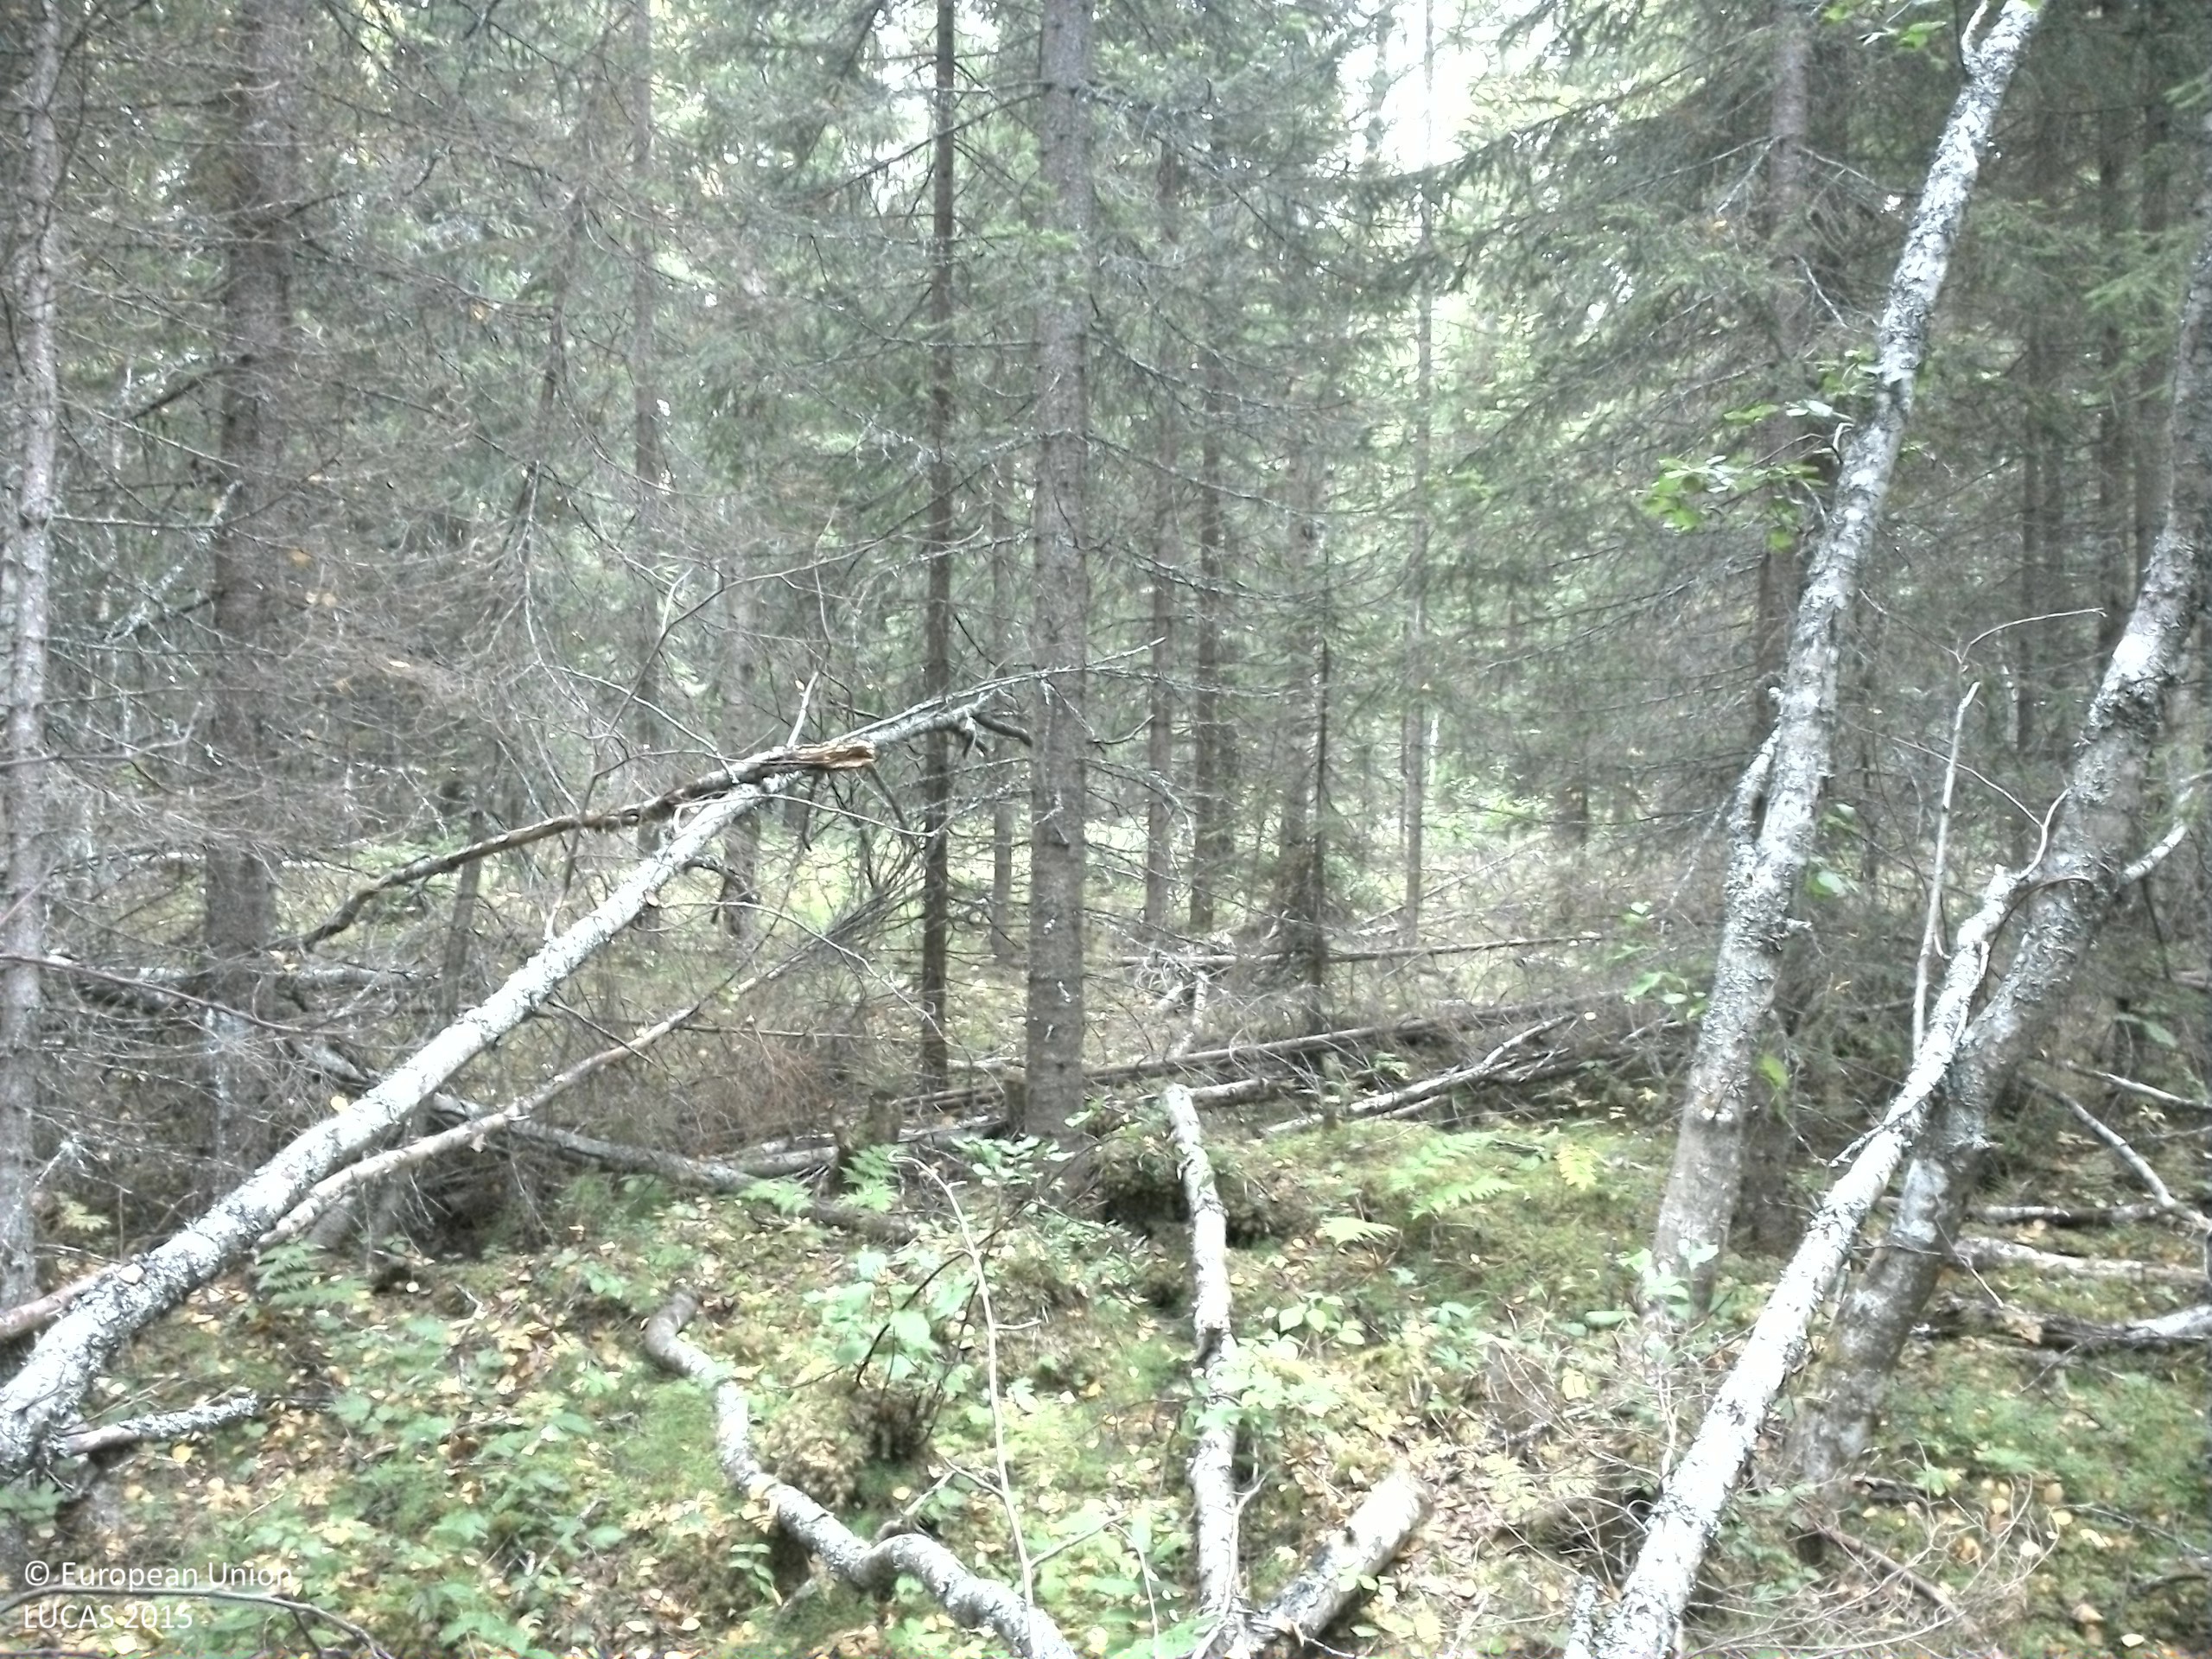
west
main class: Woodland
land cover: Spruce dominated mixed woodland
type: boreal forest
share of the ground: > 75 %
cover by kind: coniferous forest trees 55 %, broadleaved forest trees 20 %, lichens and mosses 10 %, unconsolidated bare surface 10 %, shrubs 5 %
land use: Forestry
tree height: > 5 m
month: September
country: SE
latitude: 63.6371
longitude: 15.8878
